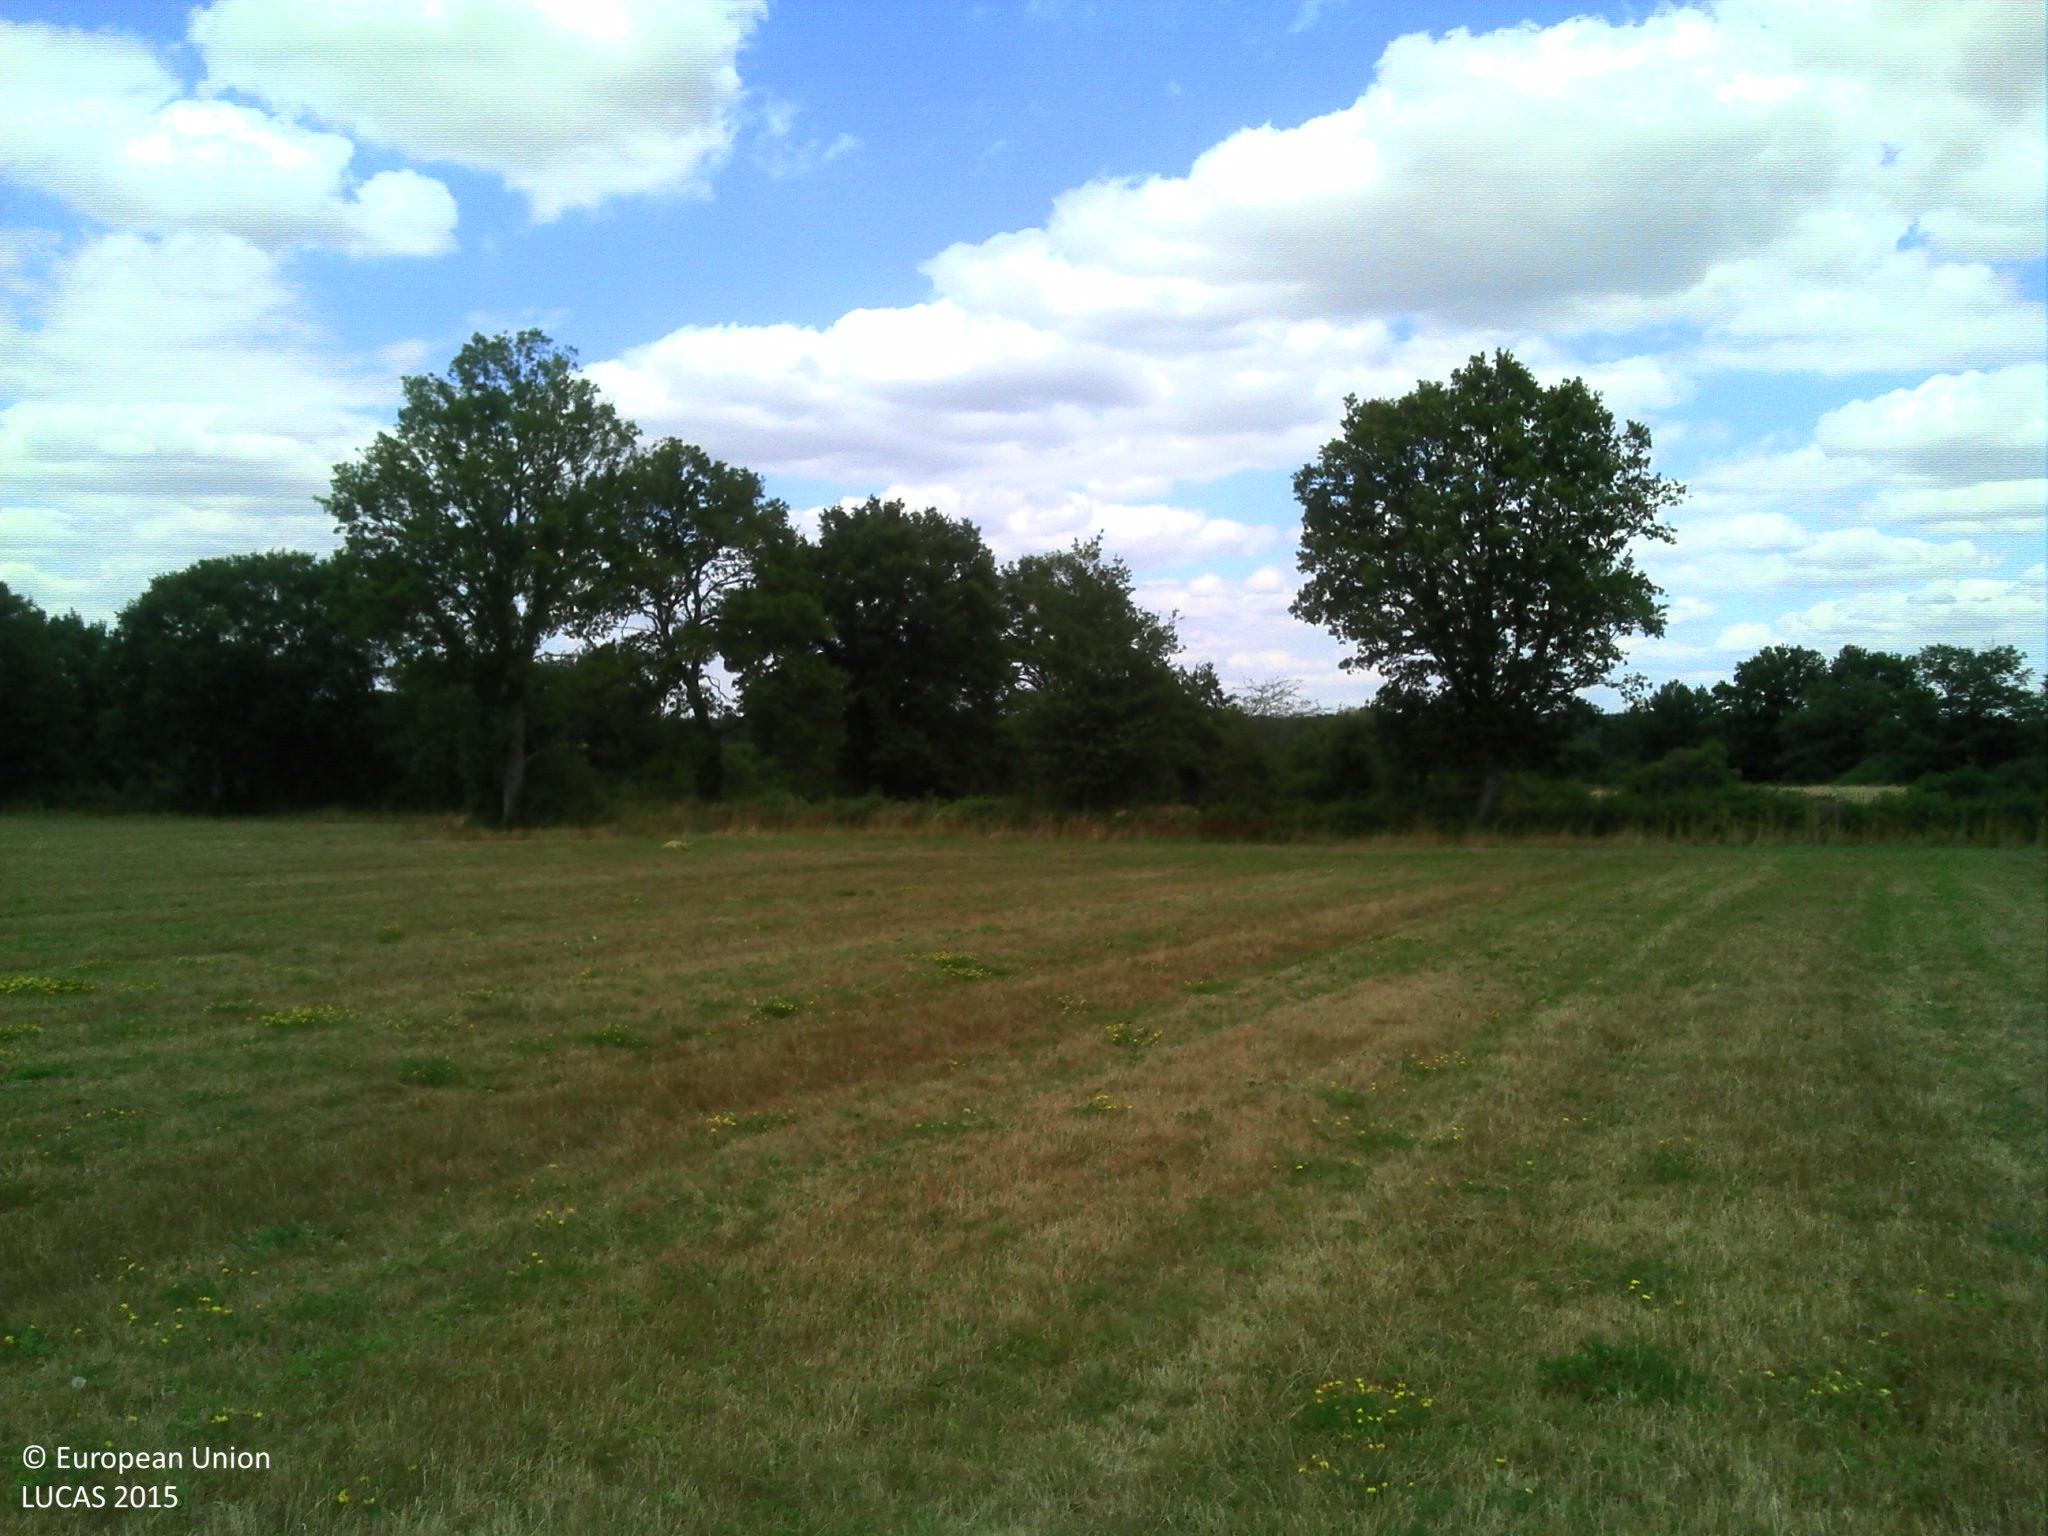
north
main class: Grassland
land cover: Grassland without tree/shrub cover
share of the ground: > 75 %
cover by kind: herbaceous plants 100 %
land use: Agriculture (excluding fallow land and kitchen gardens)
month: July
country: FR
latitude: 46.4910
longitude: 2.8441
